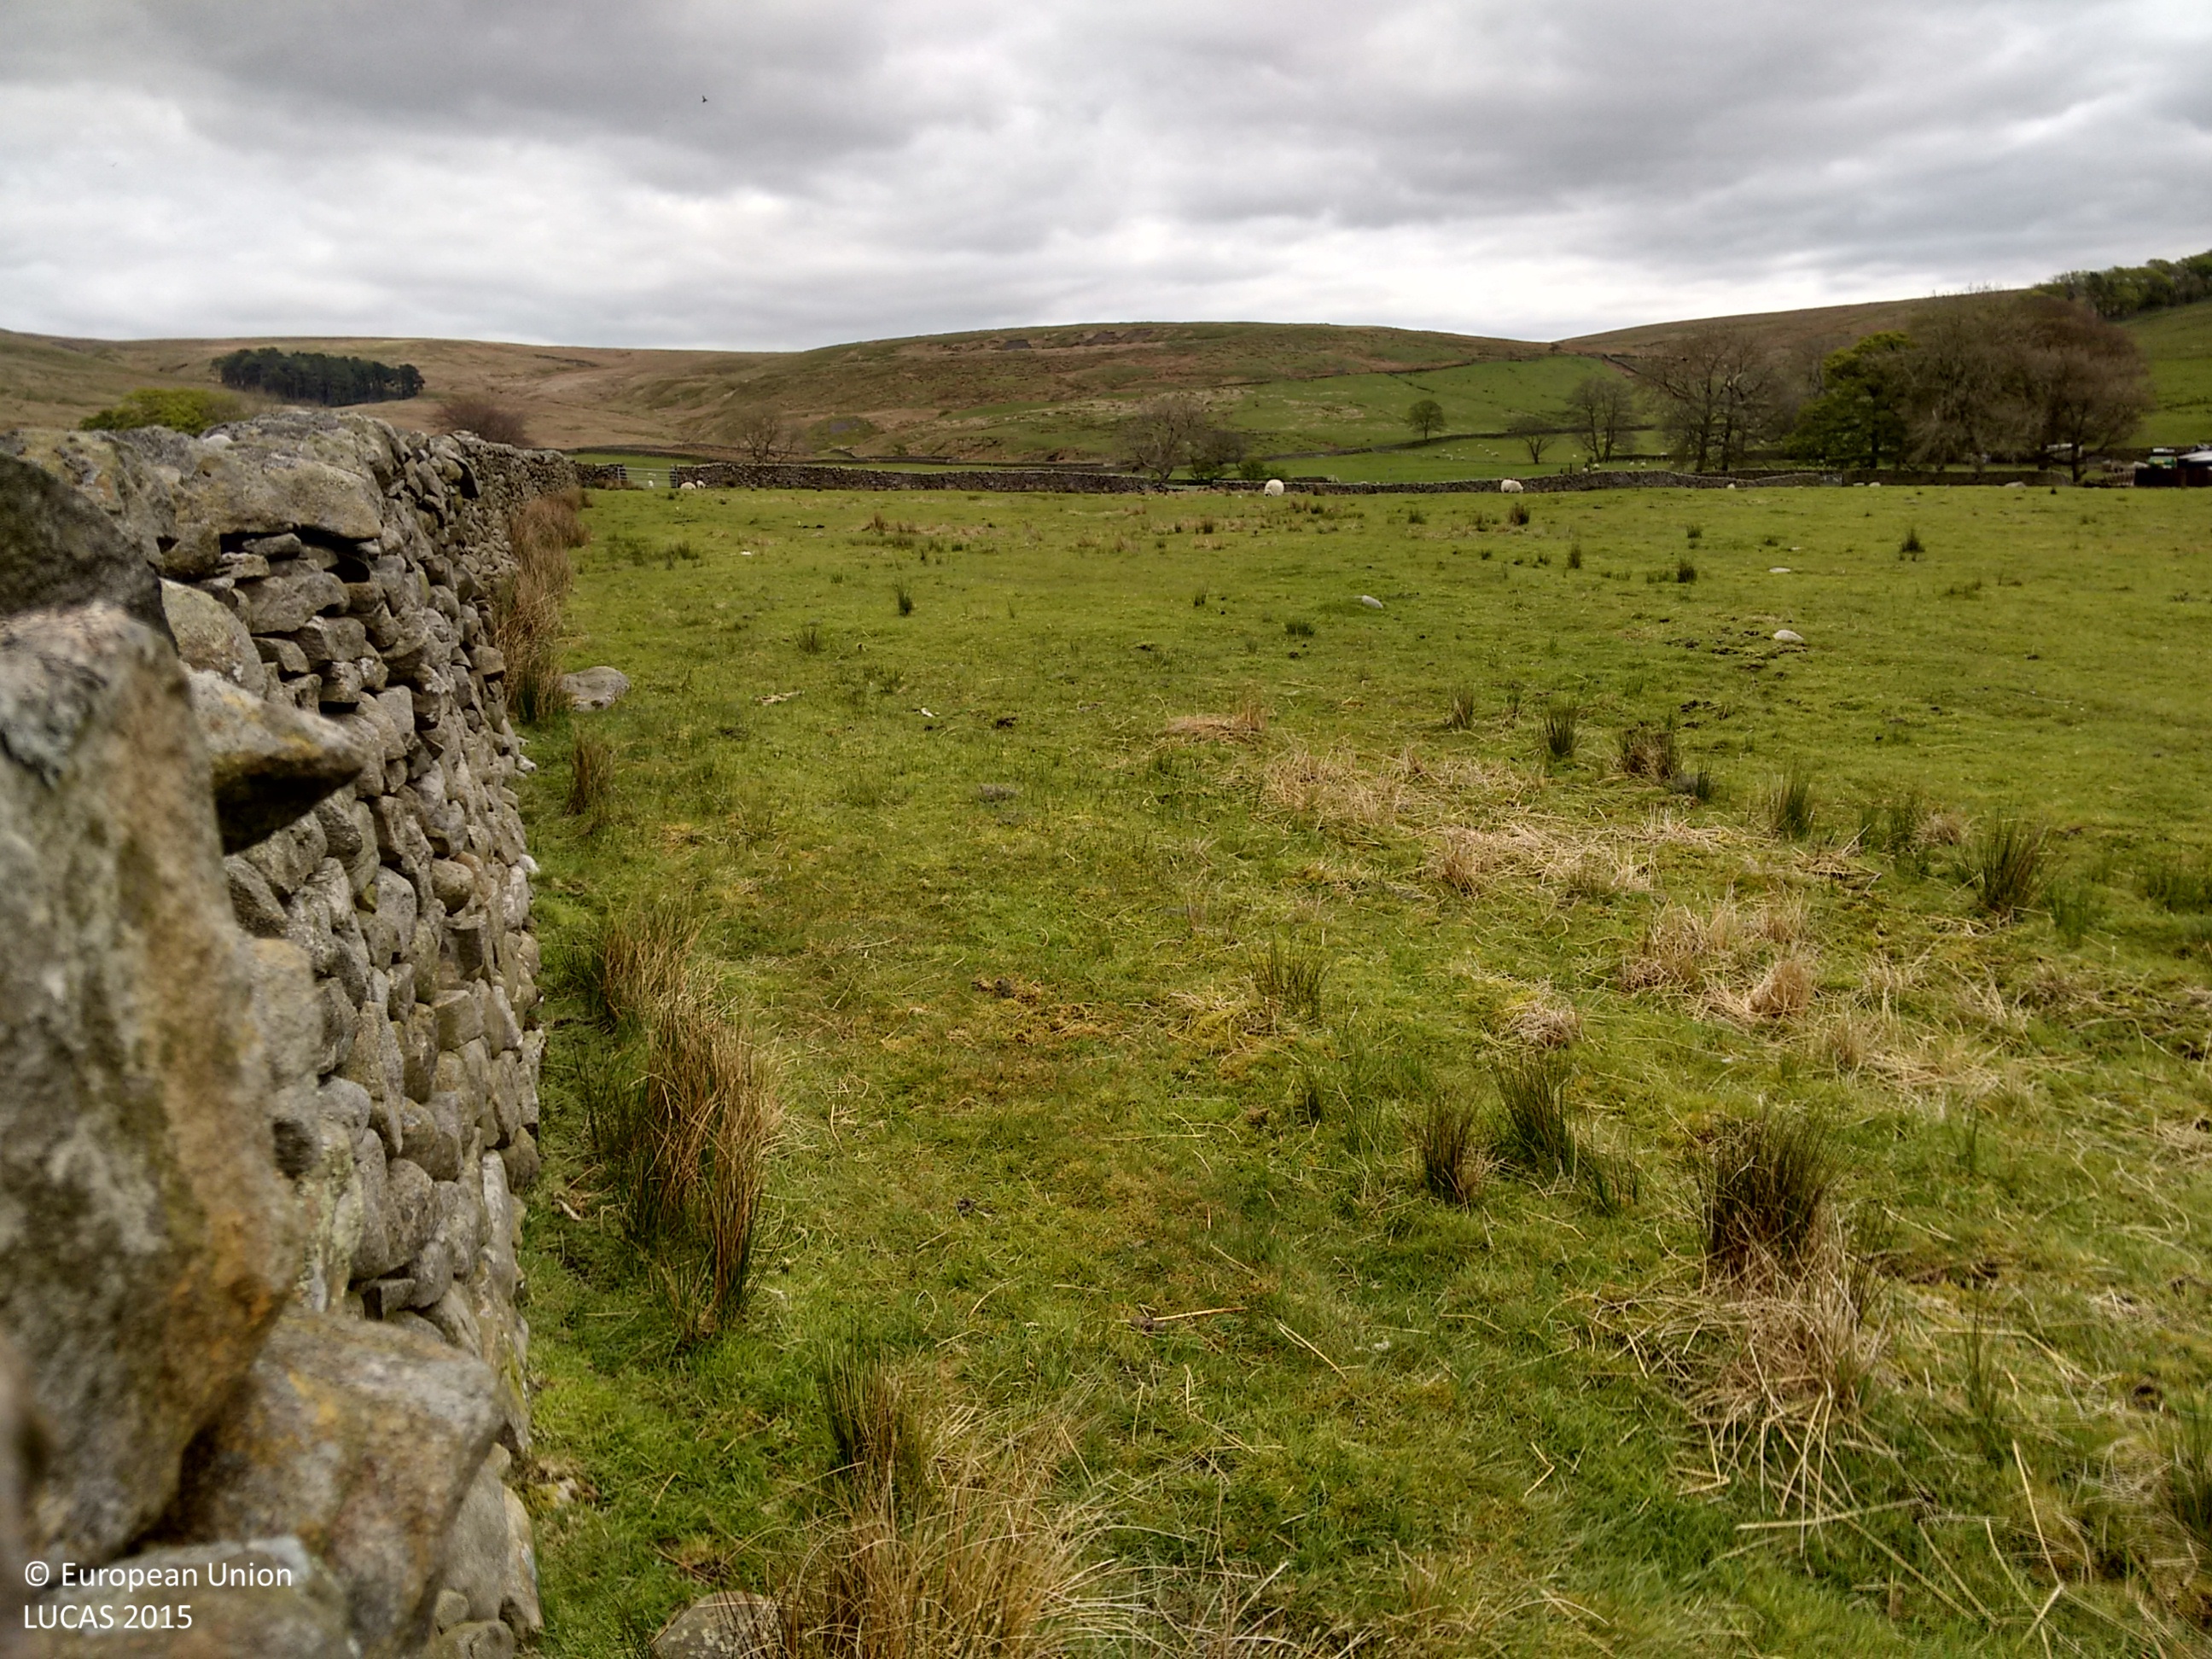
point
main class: Grassland
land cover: Grassland without tree/shrub cover
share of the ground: > 75 %
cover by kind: herbaceous plants 100 %
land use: Agriculture (excluding fallow land and kitchen gardens)
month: May
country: GB
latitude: 53.9948
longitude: -2.6206
